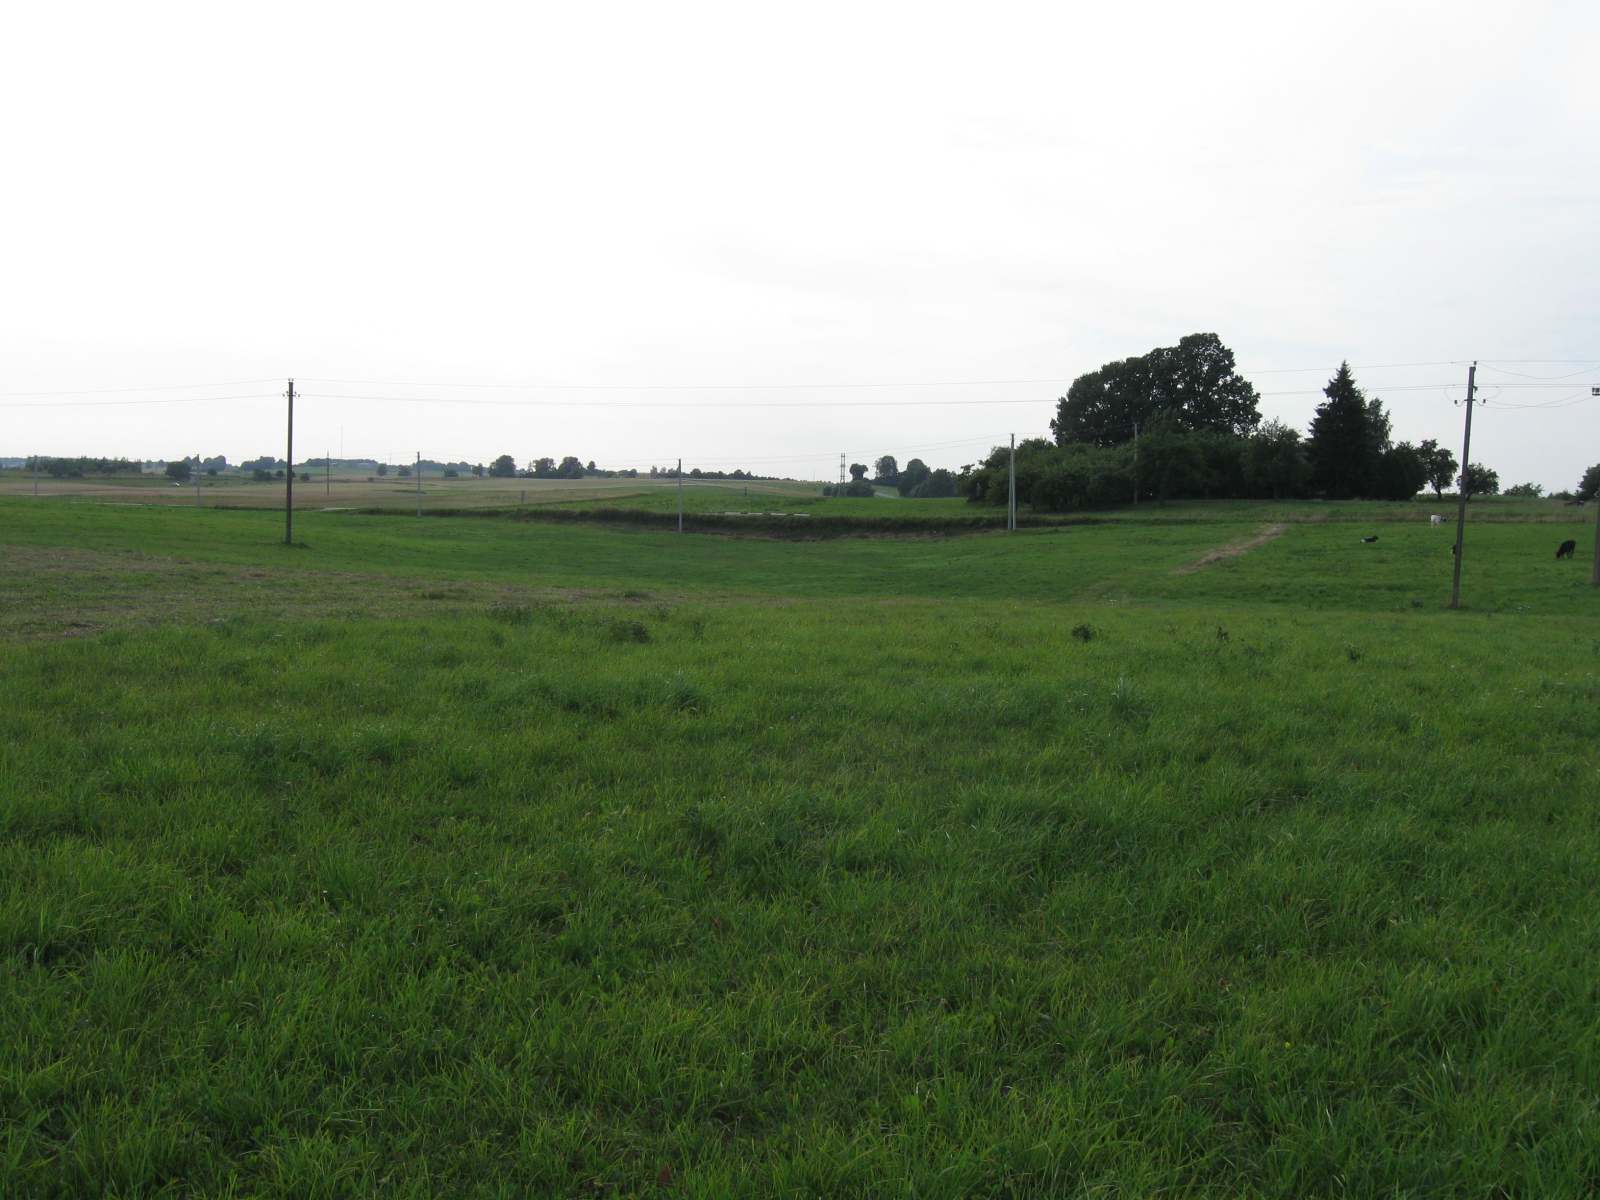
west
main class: Grassland
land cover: Grassland without tree/shrub cover
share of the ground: > 75 %
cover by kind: herbaceous plants 100 %
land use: Agriculture (excluding fallow land and kitchen gardens)
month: July
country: LT
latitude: 54.6654
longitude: 23.8405
